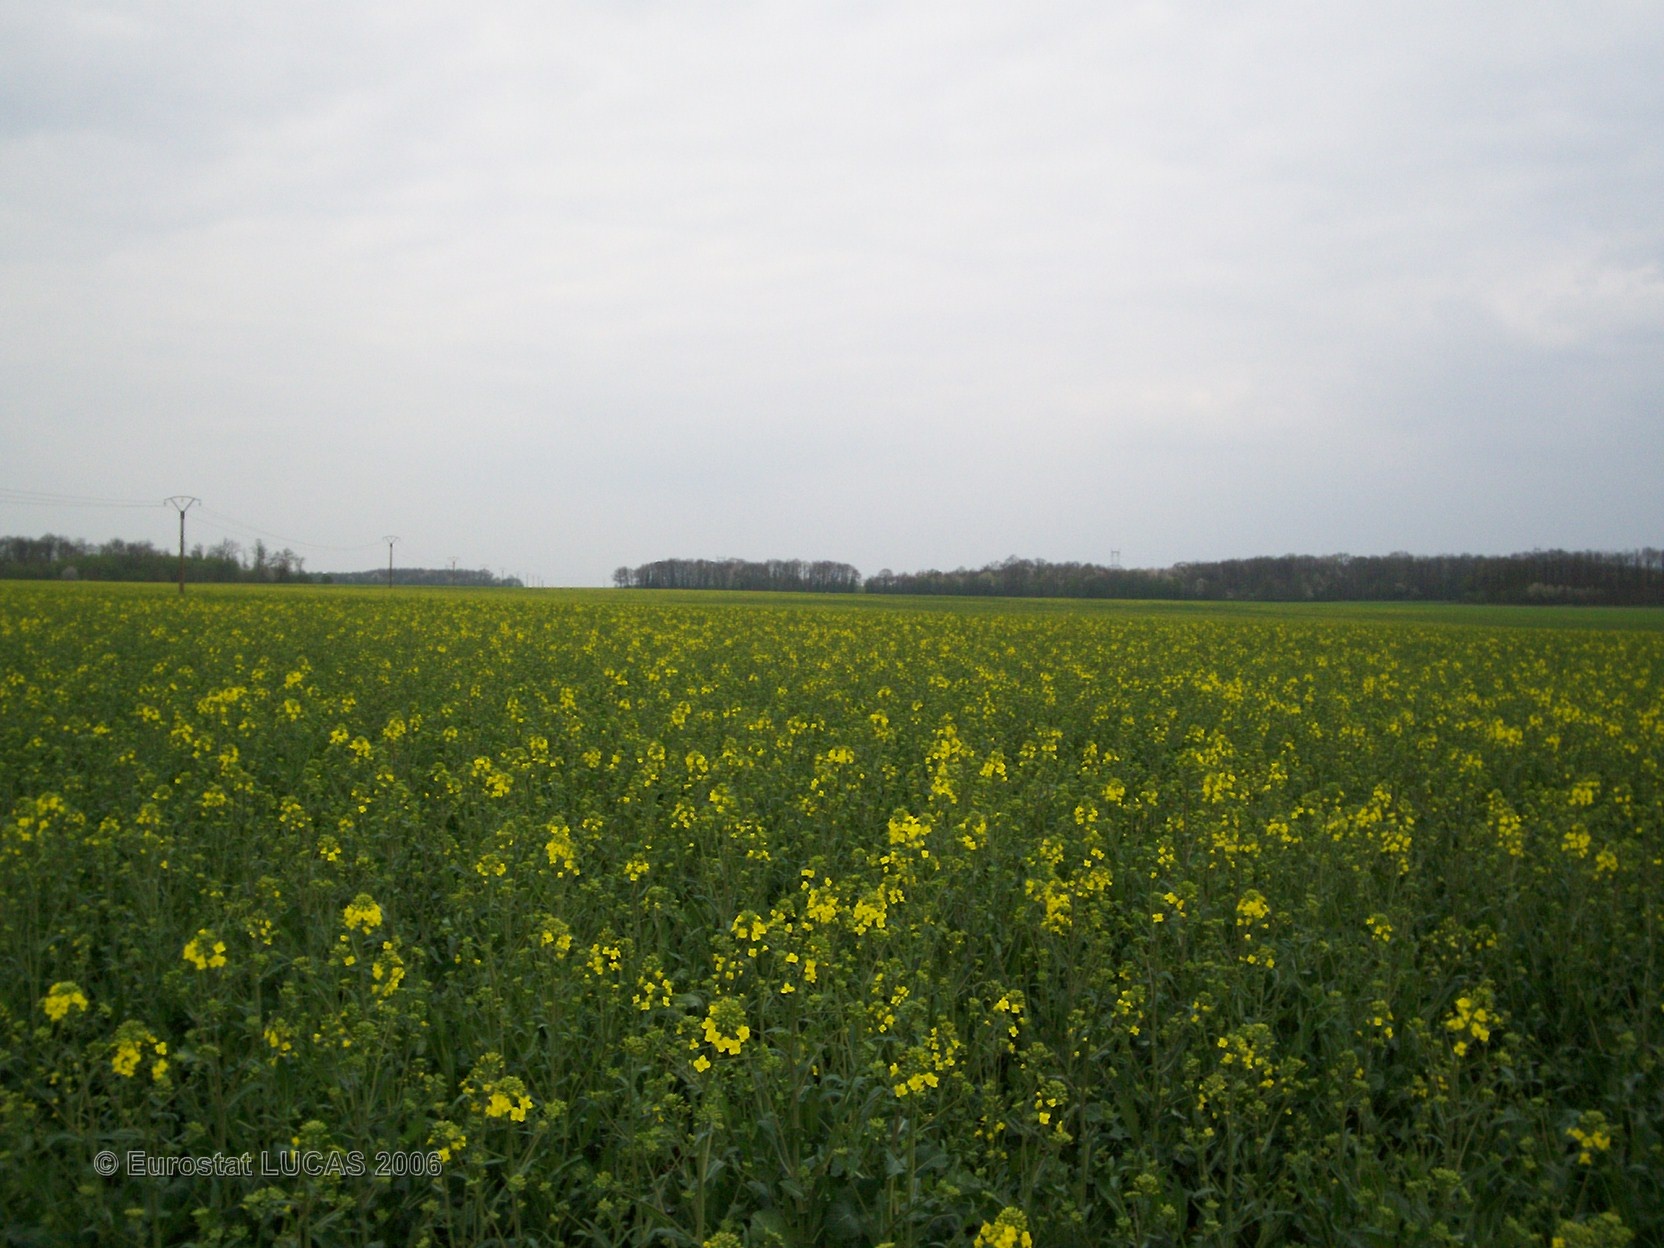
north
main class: Cropland
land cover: Rape and turnip rape
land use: Agriculture (excluding fallow land and kitchen gardens)
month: April
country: FR
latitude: 48.8725
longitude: 1.0487
